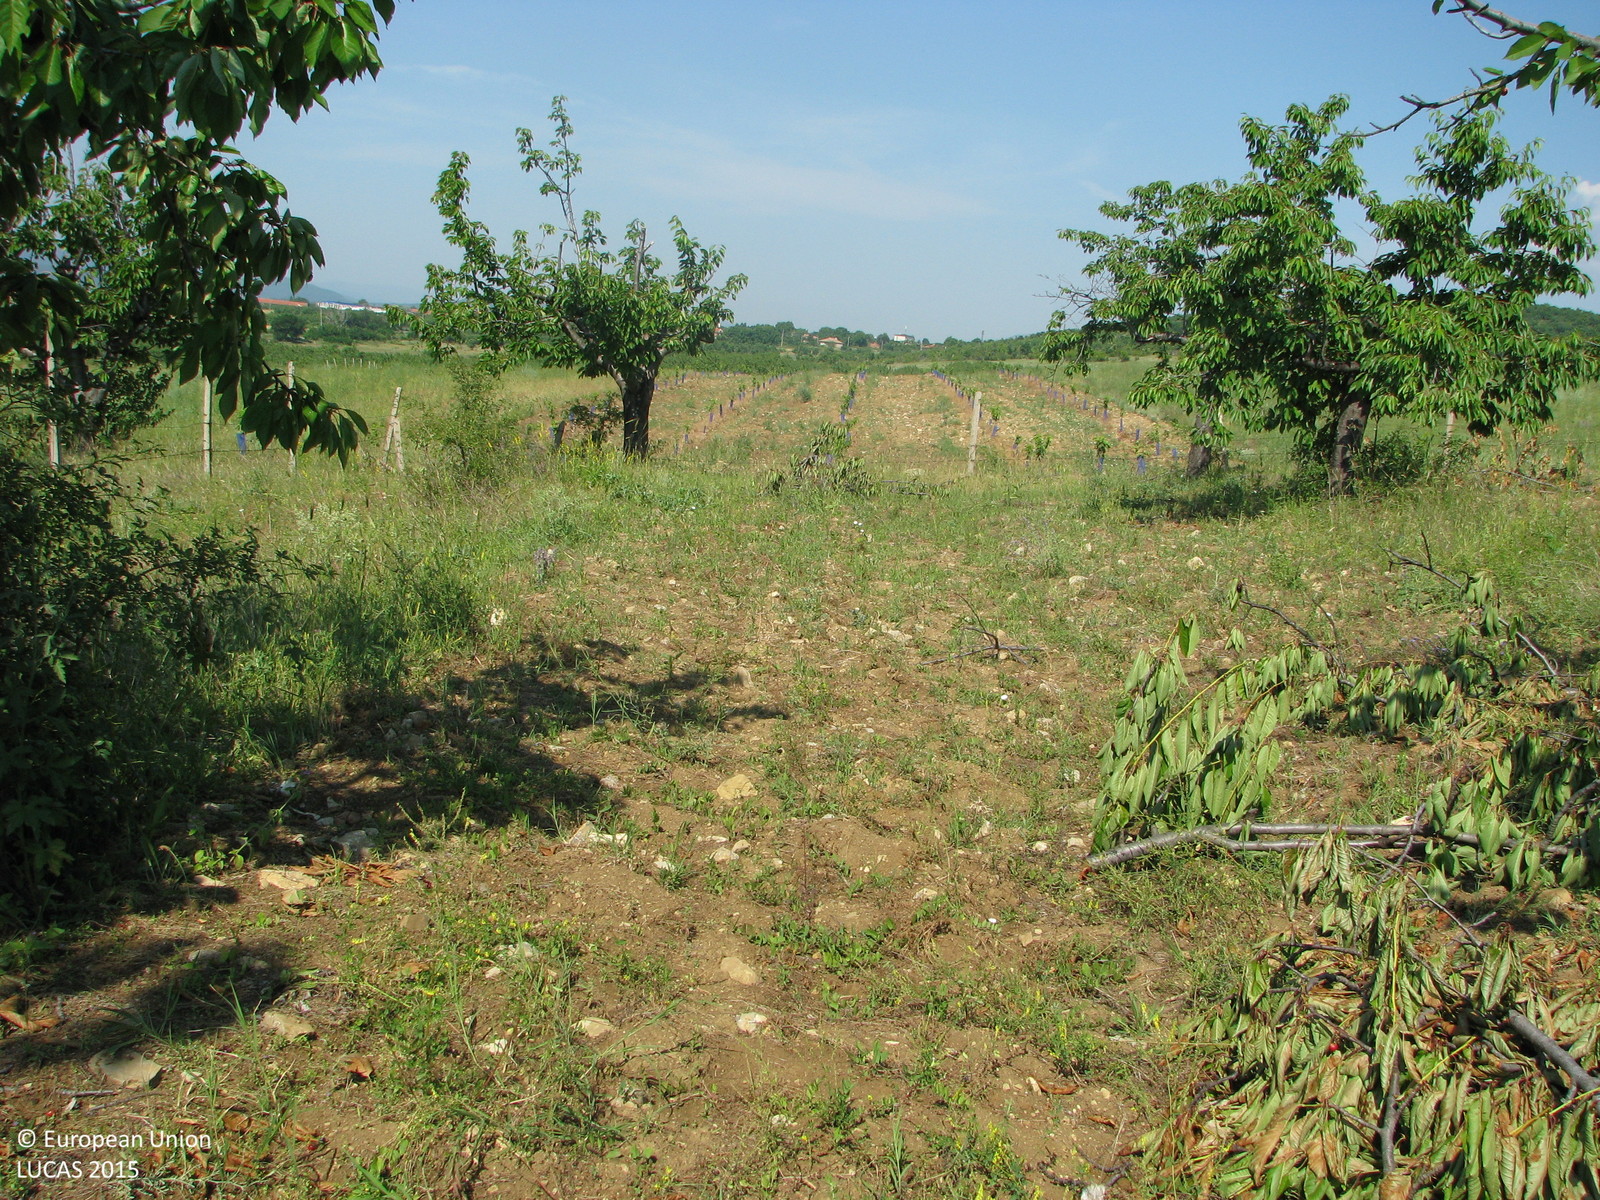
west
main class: Cropland
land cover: Cherry fruit
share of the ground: 25 - 50 %
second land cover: Spontaneously vegetated surfaces
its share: > 75 %
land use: Agriculture (excluding fallow land and kitchen gardens)
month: June
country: BG
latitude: 42.6449
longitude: 26.1990
